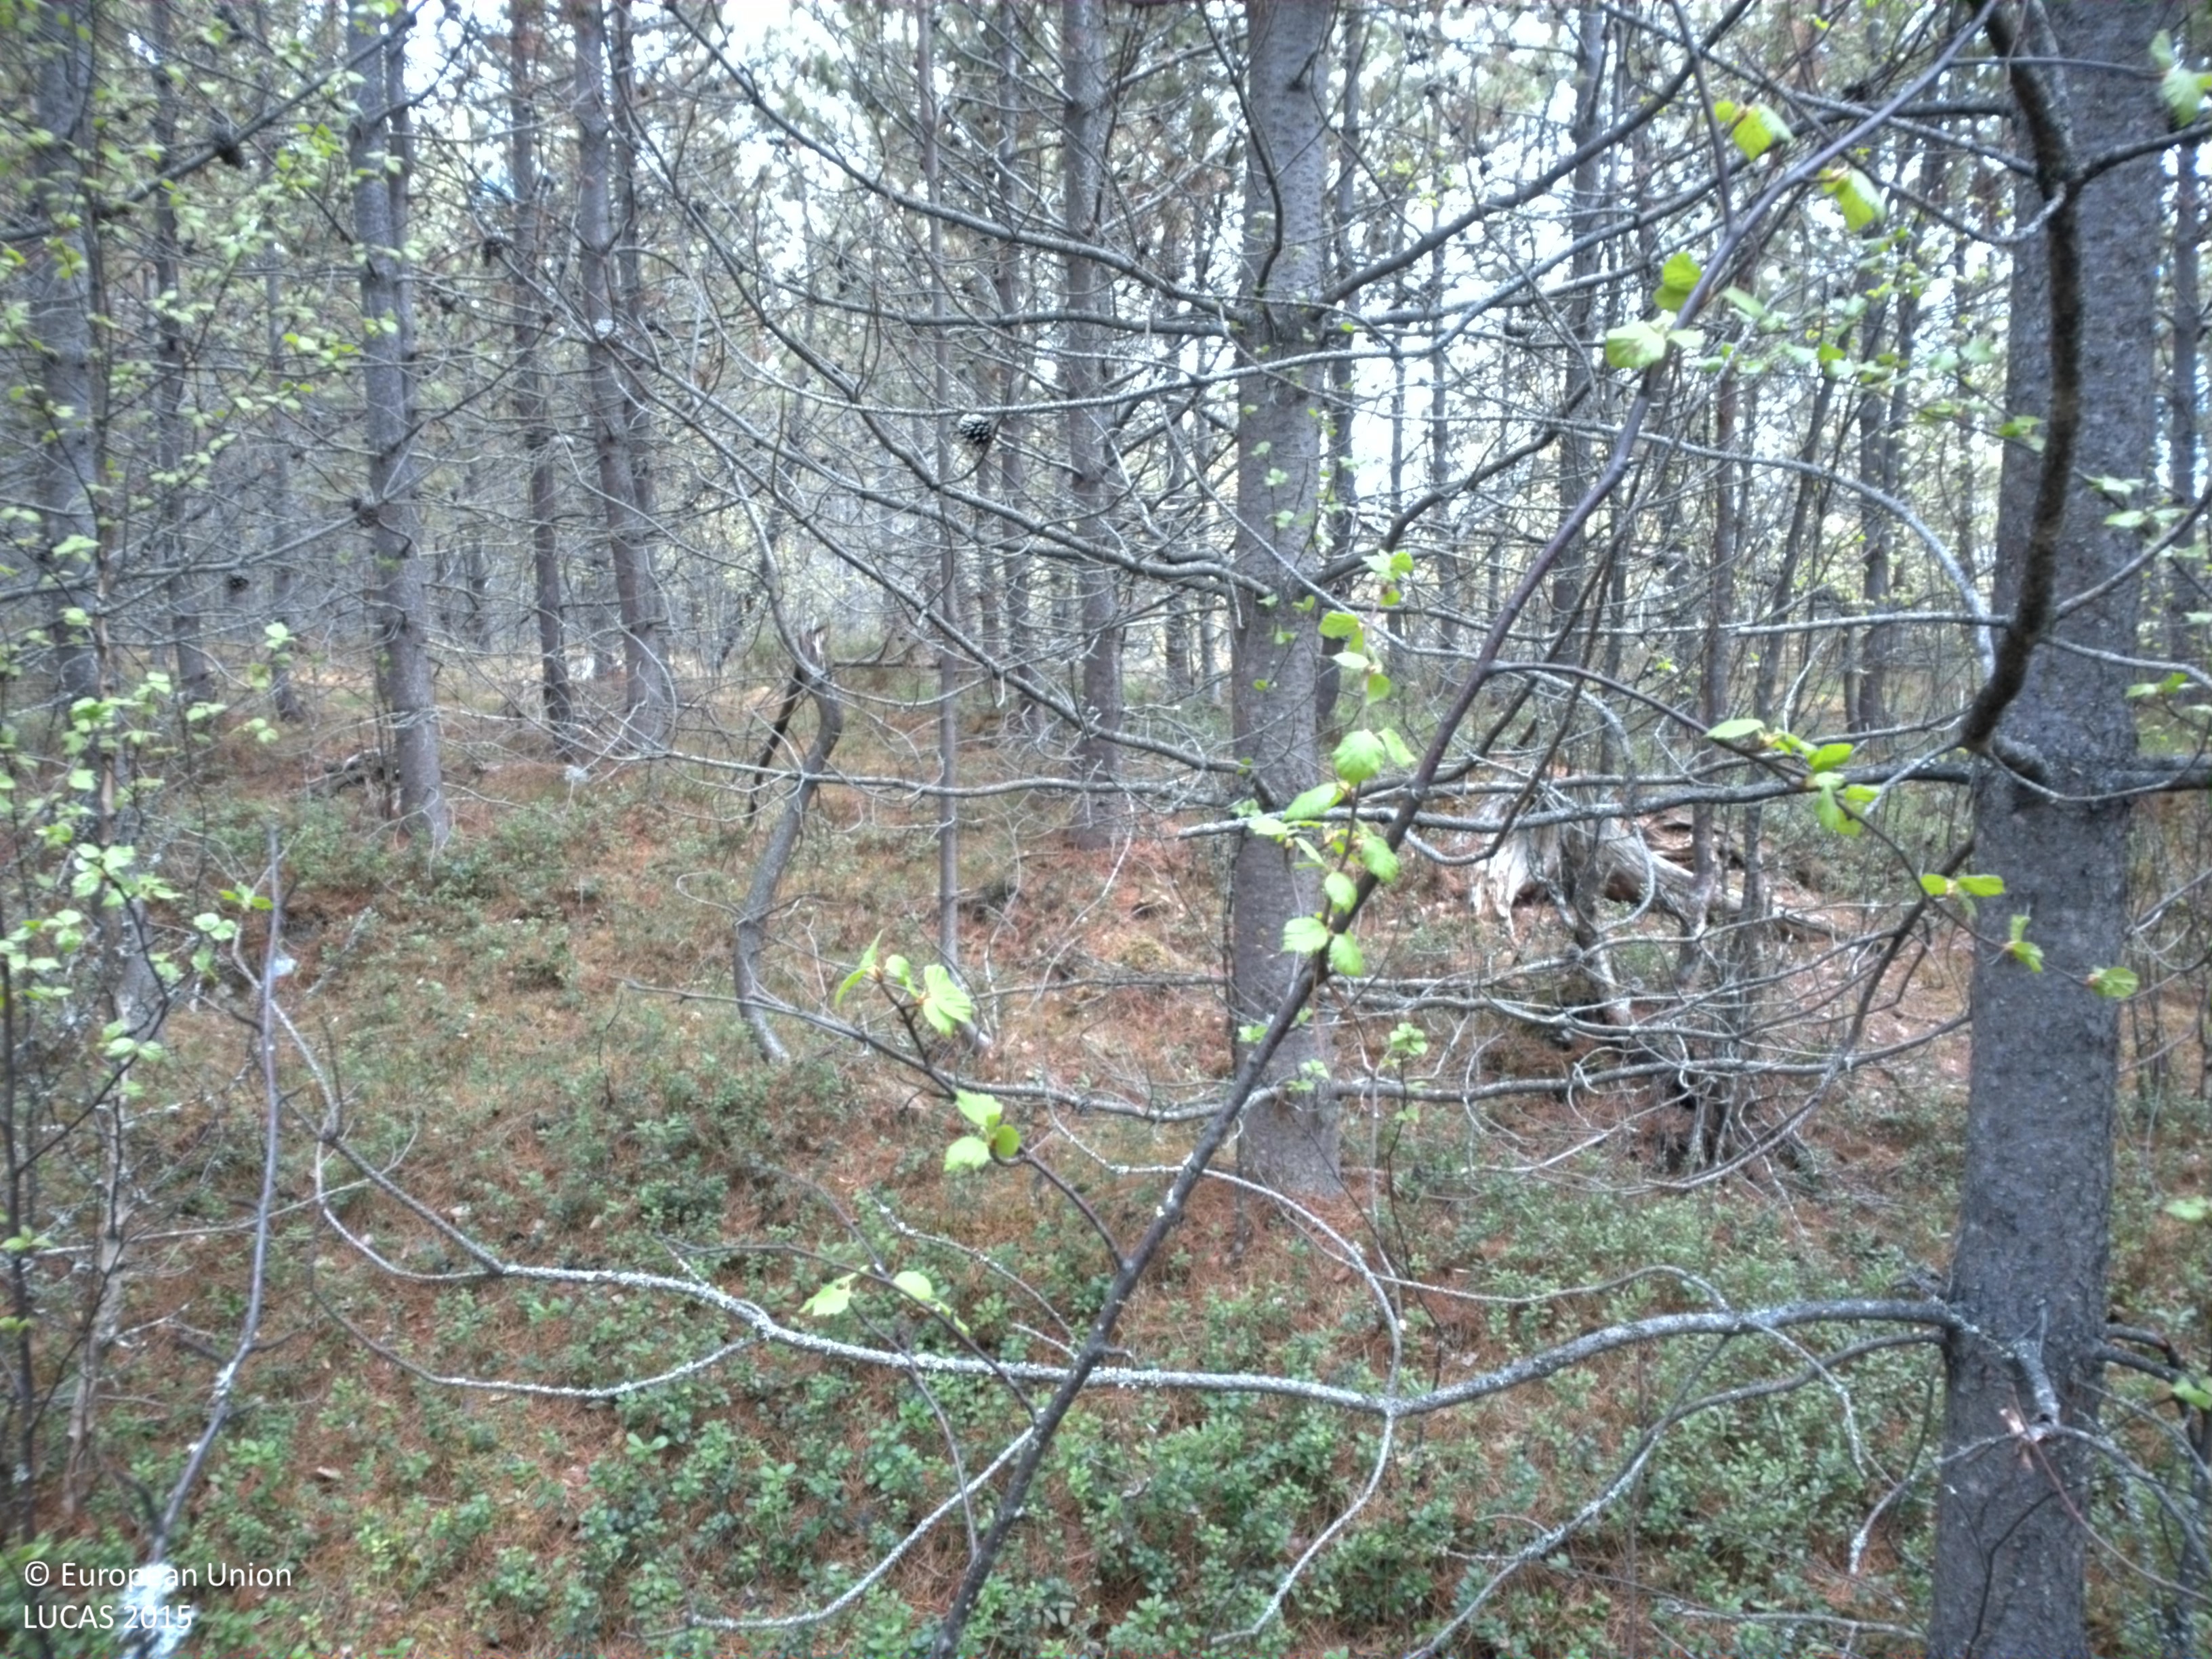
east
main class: Woodland
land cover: Pine dominated coniferous woodland
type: exotic forest
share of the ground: > 75 %
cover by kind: coniferous forest trees 75 %, herbaceous plants 10 %, lichens and mosses 10 %, broadleaved forest trees 5 %
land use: Forestry
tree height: > 5 m
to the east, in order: Pine dominated coniferous woodland; Shrubland with sparse tree cover; Spruce dominated coniferous woodland; Shrubland with sparse tree cover; Spruce dominated mixed woodland; Ditches and canals; Spruce dominated coniferous woodland; Spruce dominated mixed woodland; Ditches and canals; Shrubland with sparse tree cover
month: June
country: SE
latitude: 64.2850
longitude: 17.6736
